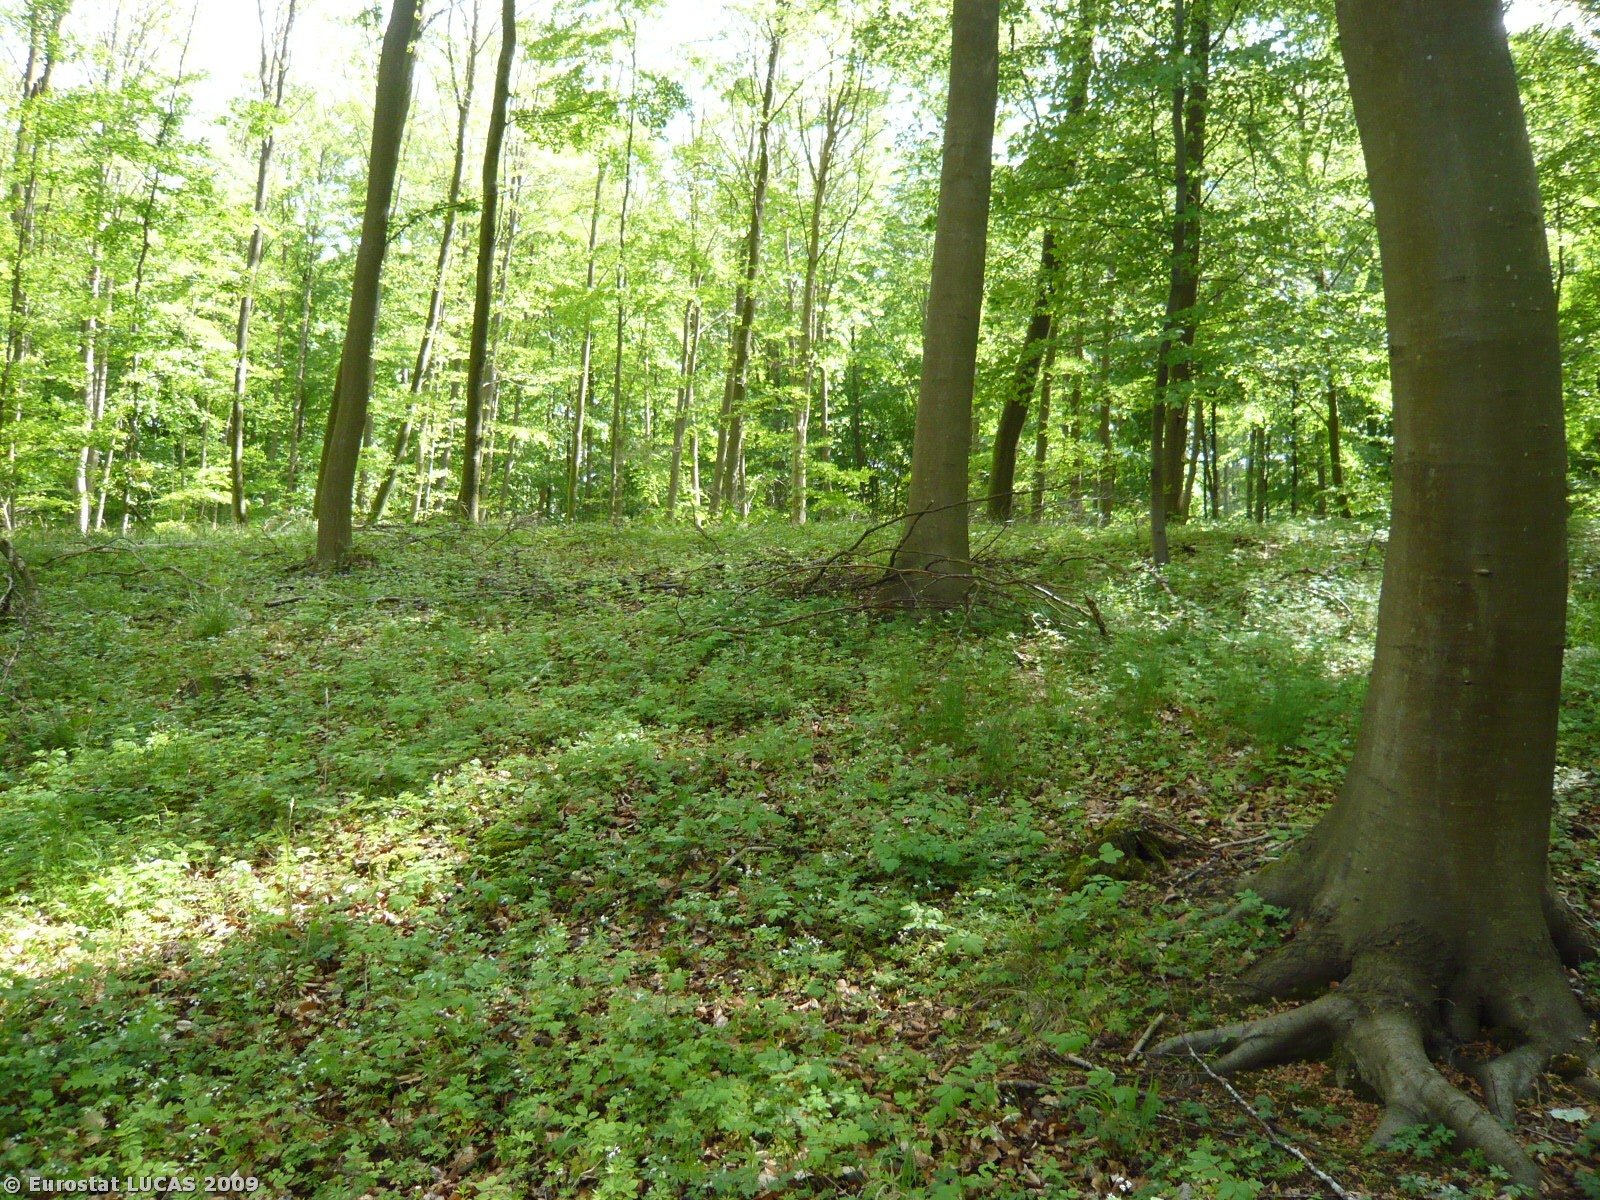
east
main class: Woodland
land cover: Broadleaved woodland
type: mesophytic deciduous forest
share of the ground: > 75 %
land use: Forestry
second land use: Amenities, museums, leisure
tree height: > 5 m
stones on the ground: < 10 %
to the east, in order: Broadleaved woodland; Tracks; Broadleaved woodland; Tracks; Grass margins; Coniferous woodland
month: May
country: DK
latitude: 55.6340
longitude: 11.9204
